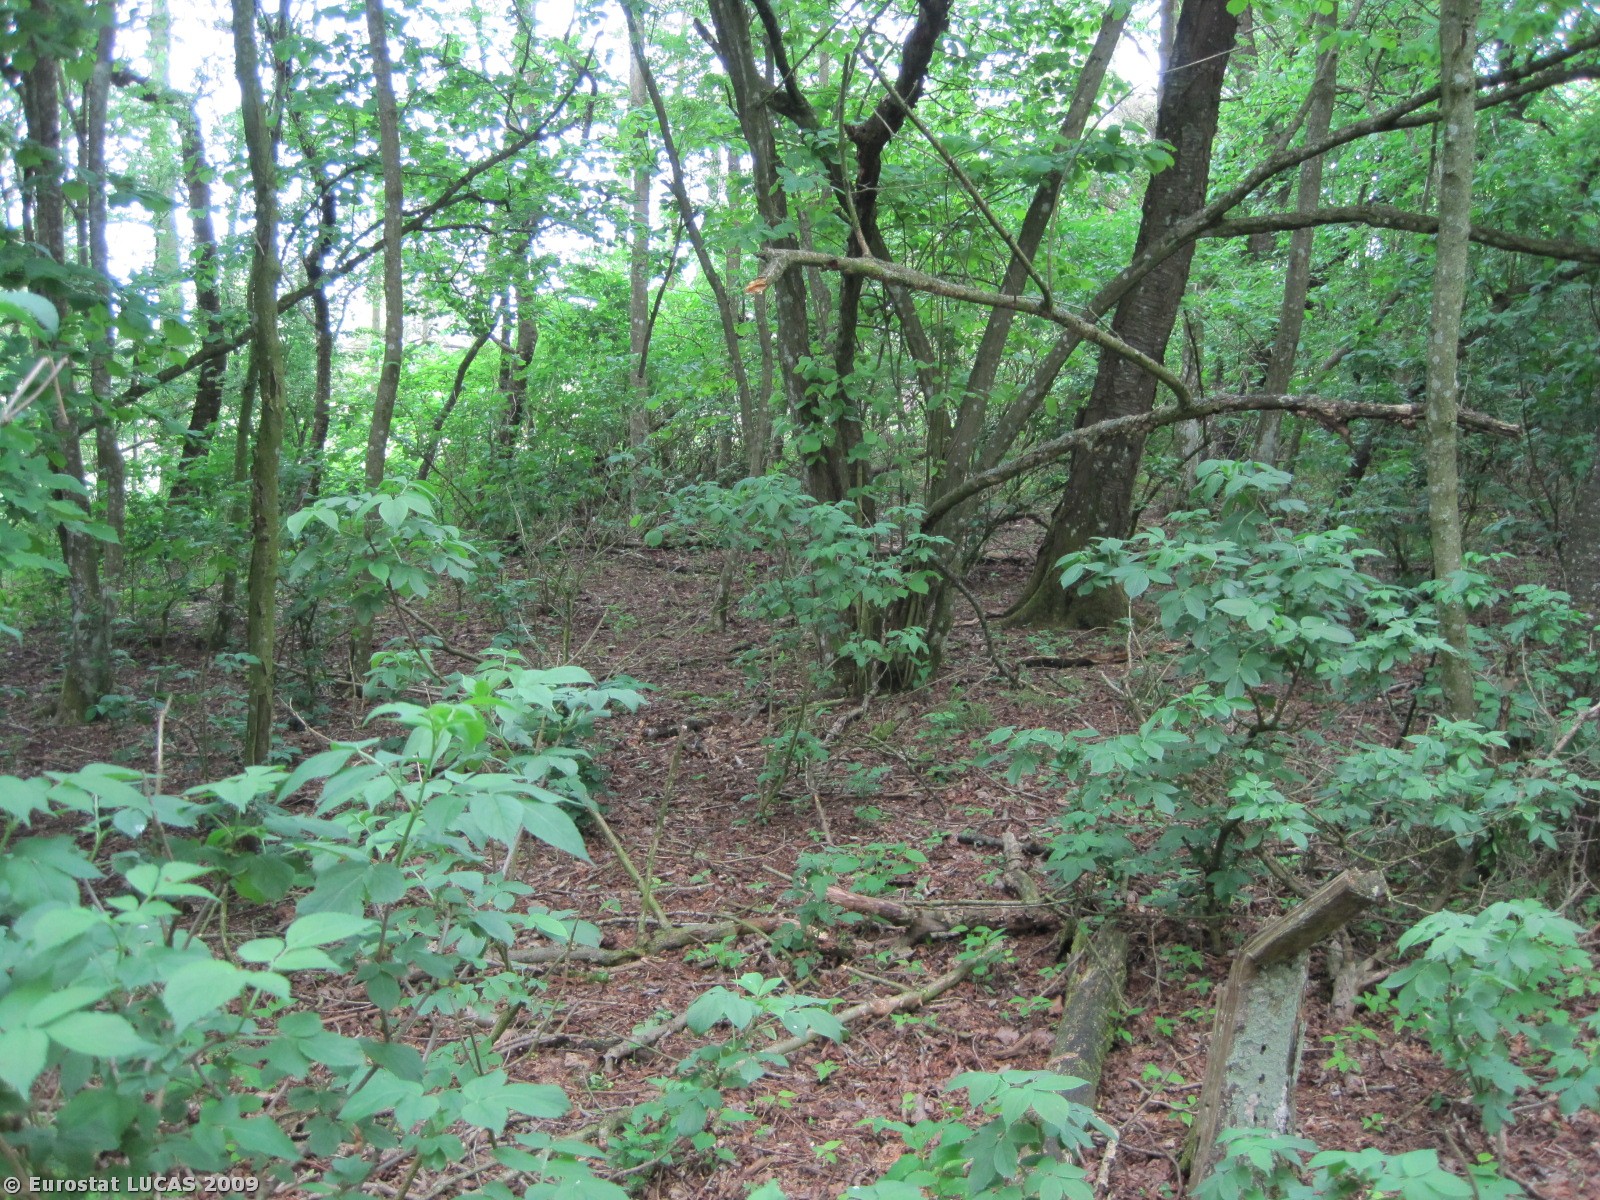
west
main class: Woodland
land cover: Broadleaved woodland
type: plantations and self-sown exotic forest
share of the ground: > 75 %
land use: Unused
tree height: > 5 m
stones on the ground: < 10 %
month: May
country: DK
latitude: 56.7450
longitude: 10.0163
